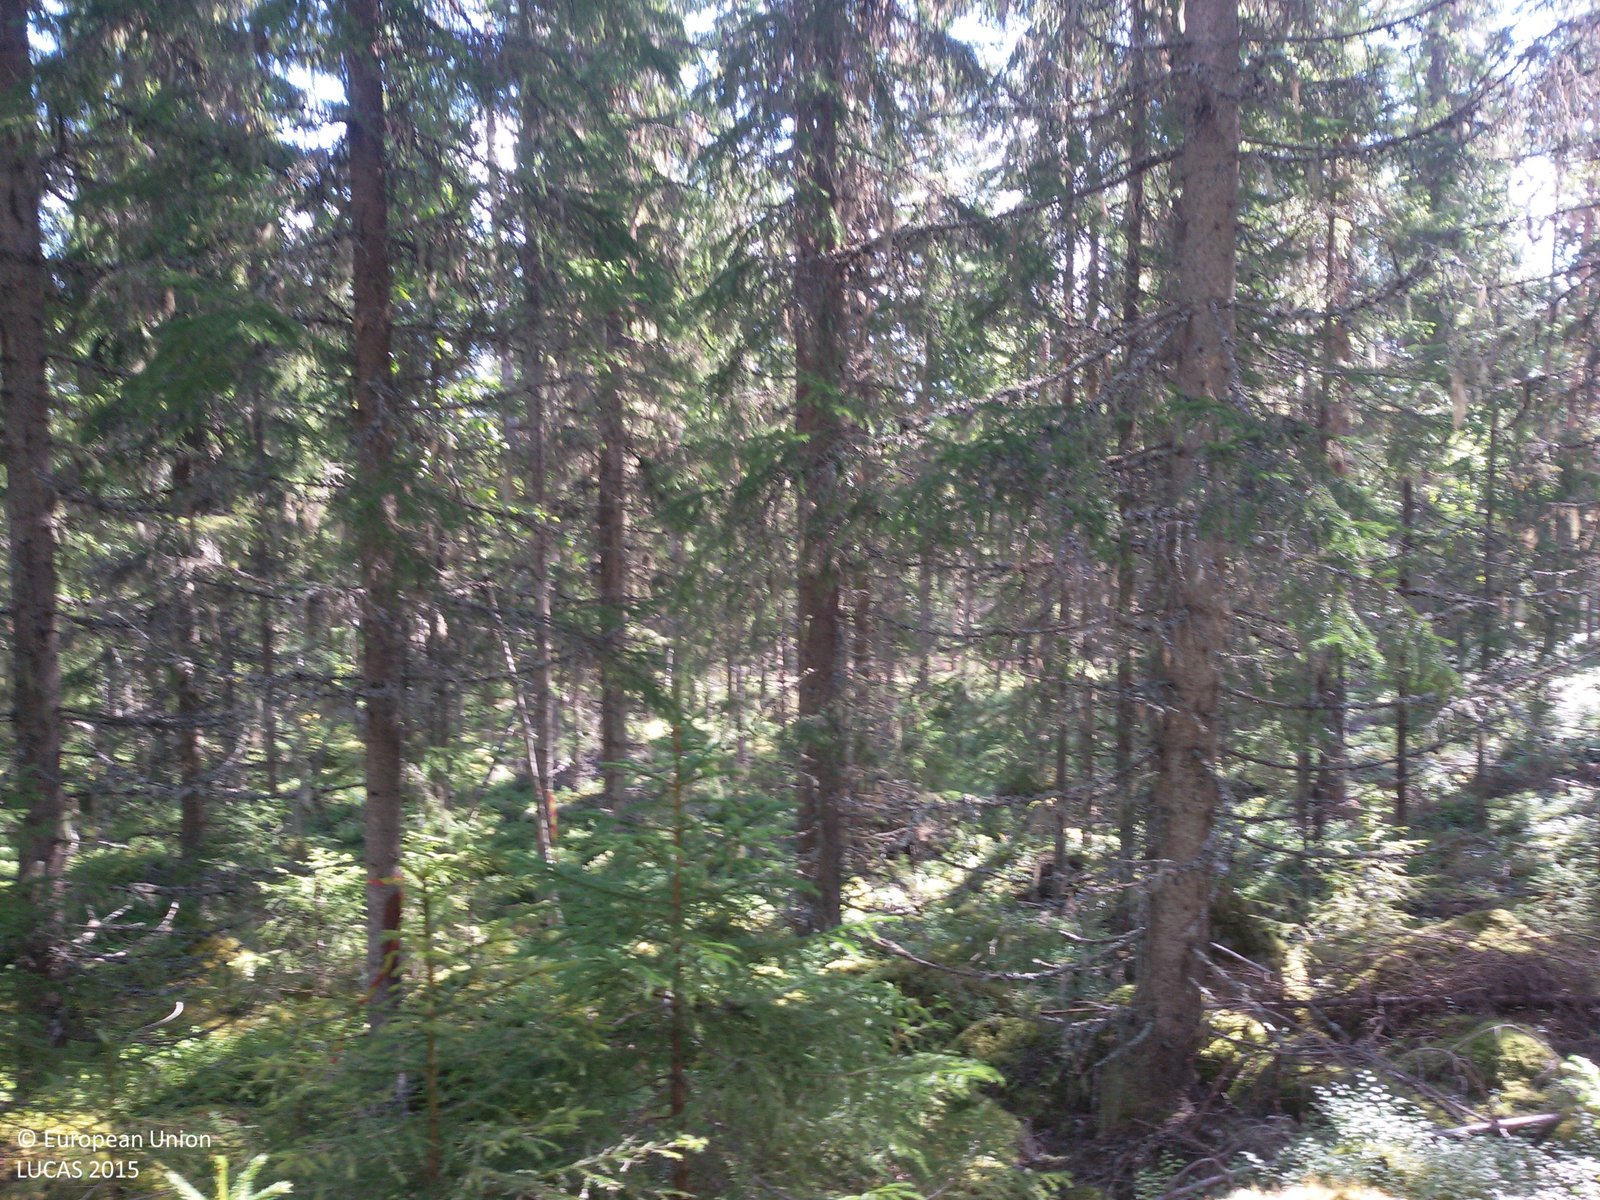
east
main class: Woodland
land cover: Spruce dominated mixed woodland
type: boreal forest
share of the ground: 50 - 75 %
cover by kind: coniferous forest trees 40 %, broadleaved forest trees 30 %, herbaceous plants 30 %
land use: Forestry
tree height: > 5 m
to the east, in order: Spruce dominated mixed woodland; Spruce dominated coniferous woodland; Spruce dominated mixed woodland; Pine dominated coniferous woodland; Paved roads, cycling and walking lanes; Spruce dominated coniferous woodland; Spruce dominated mixed woodland
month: September
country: SE
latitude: 60.8763
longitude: 15.2727
